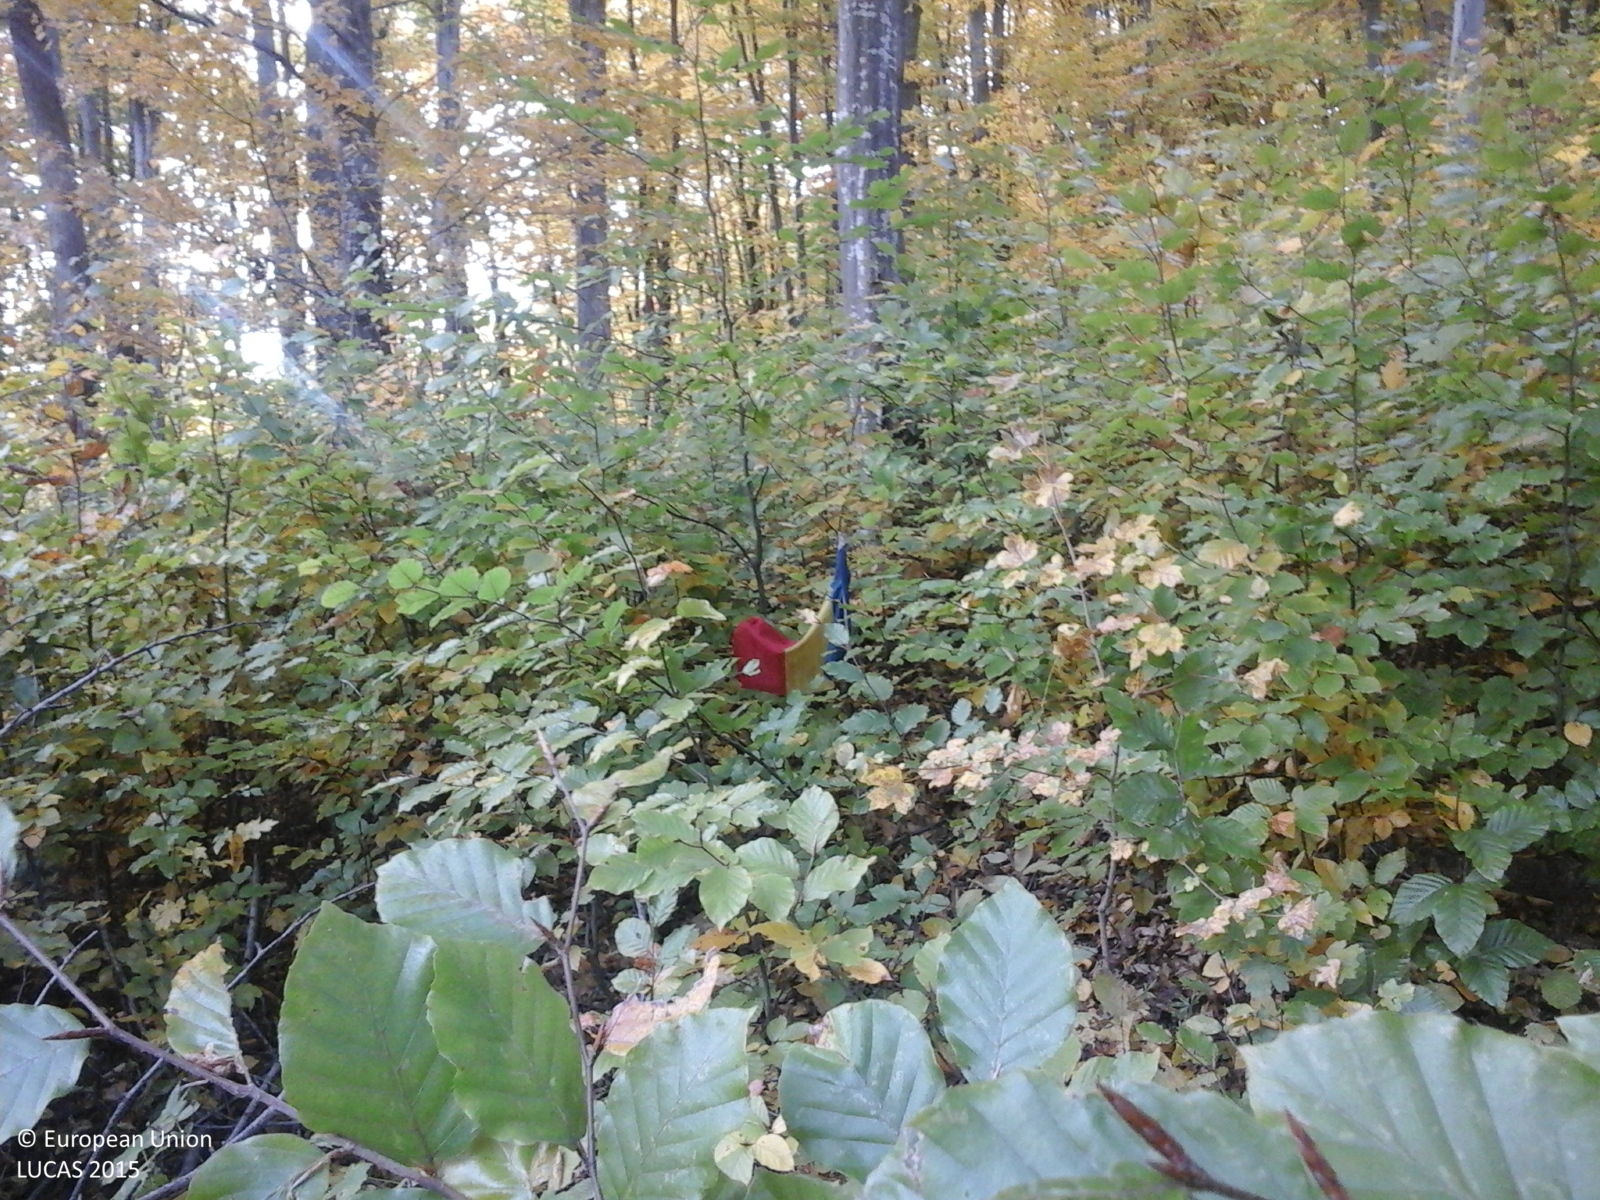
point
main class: Woodland
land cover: Broadleaved woodland
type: beech forest
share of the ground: > 75 %
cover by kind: broadleaved forest trees 100 %
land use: Forestry
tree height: > 5 m
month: October
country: RO
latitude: 45.5304
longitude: 26.7660
